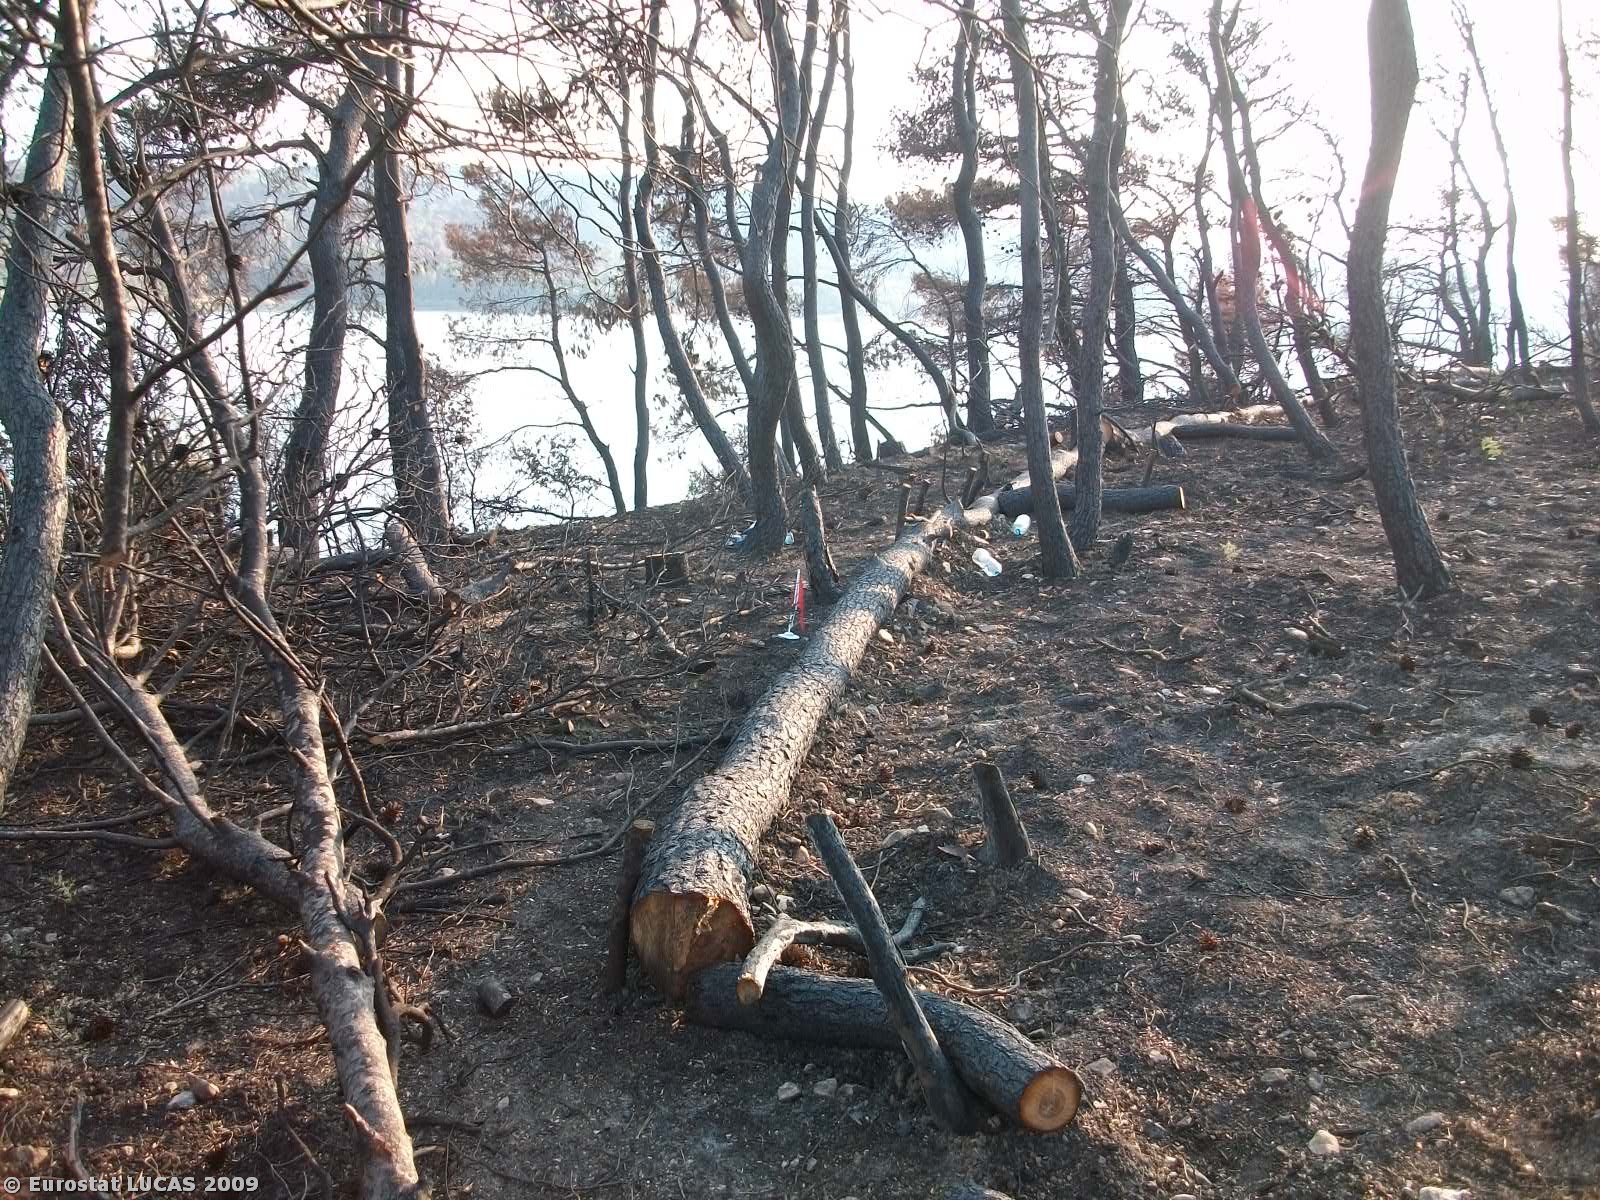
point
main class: Woodland
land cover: Coniferous woodland
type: coniferous forest of the mediterranean region
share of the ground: > 75 %
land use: Forestry
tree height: > 5 m
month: September
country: GR
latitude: 38.1720
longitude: 23.8998
